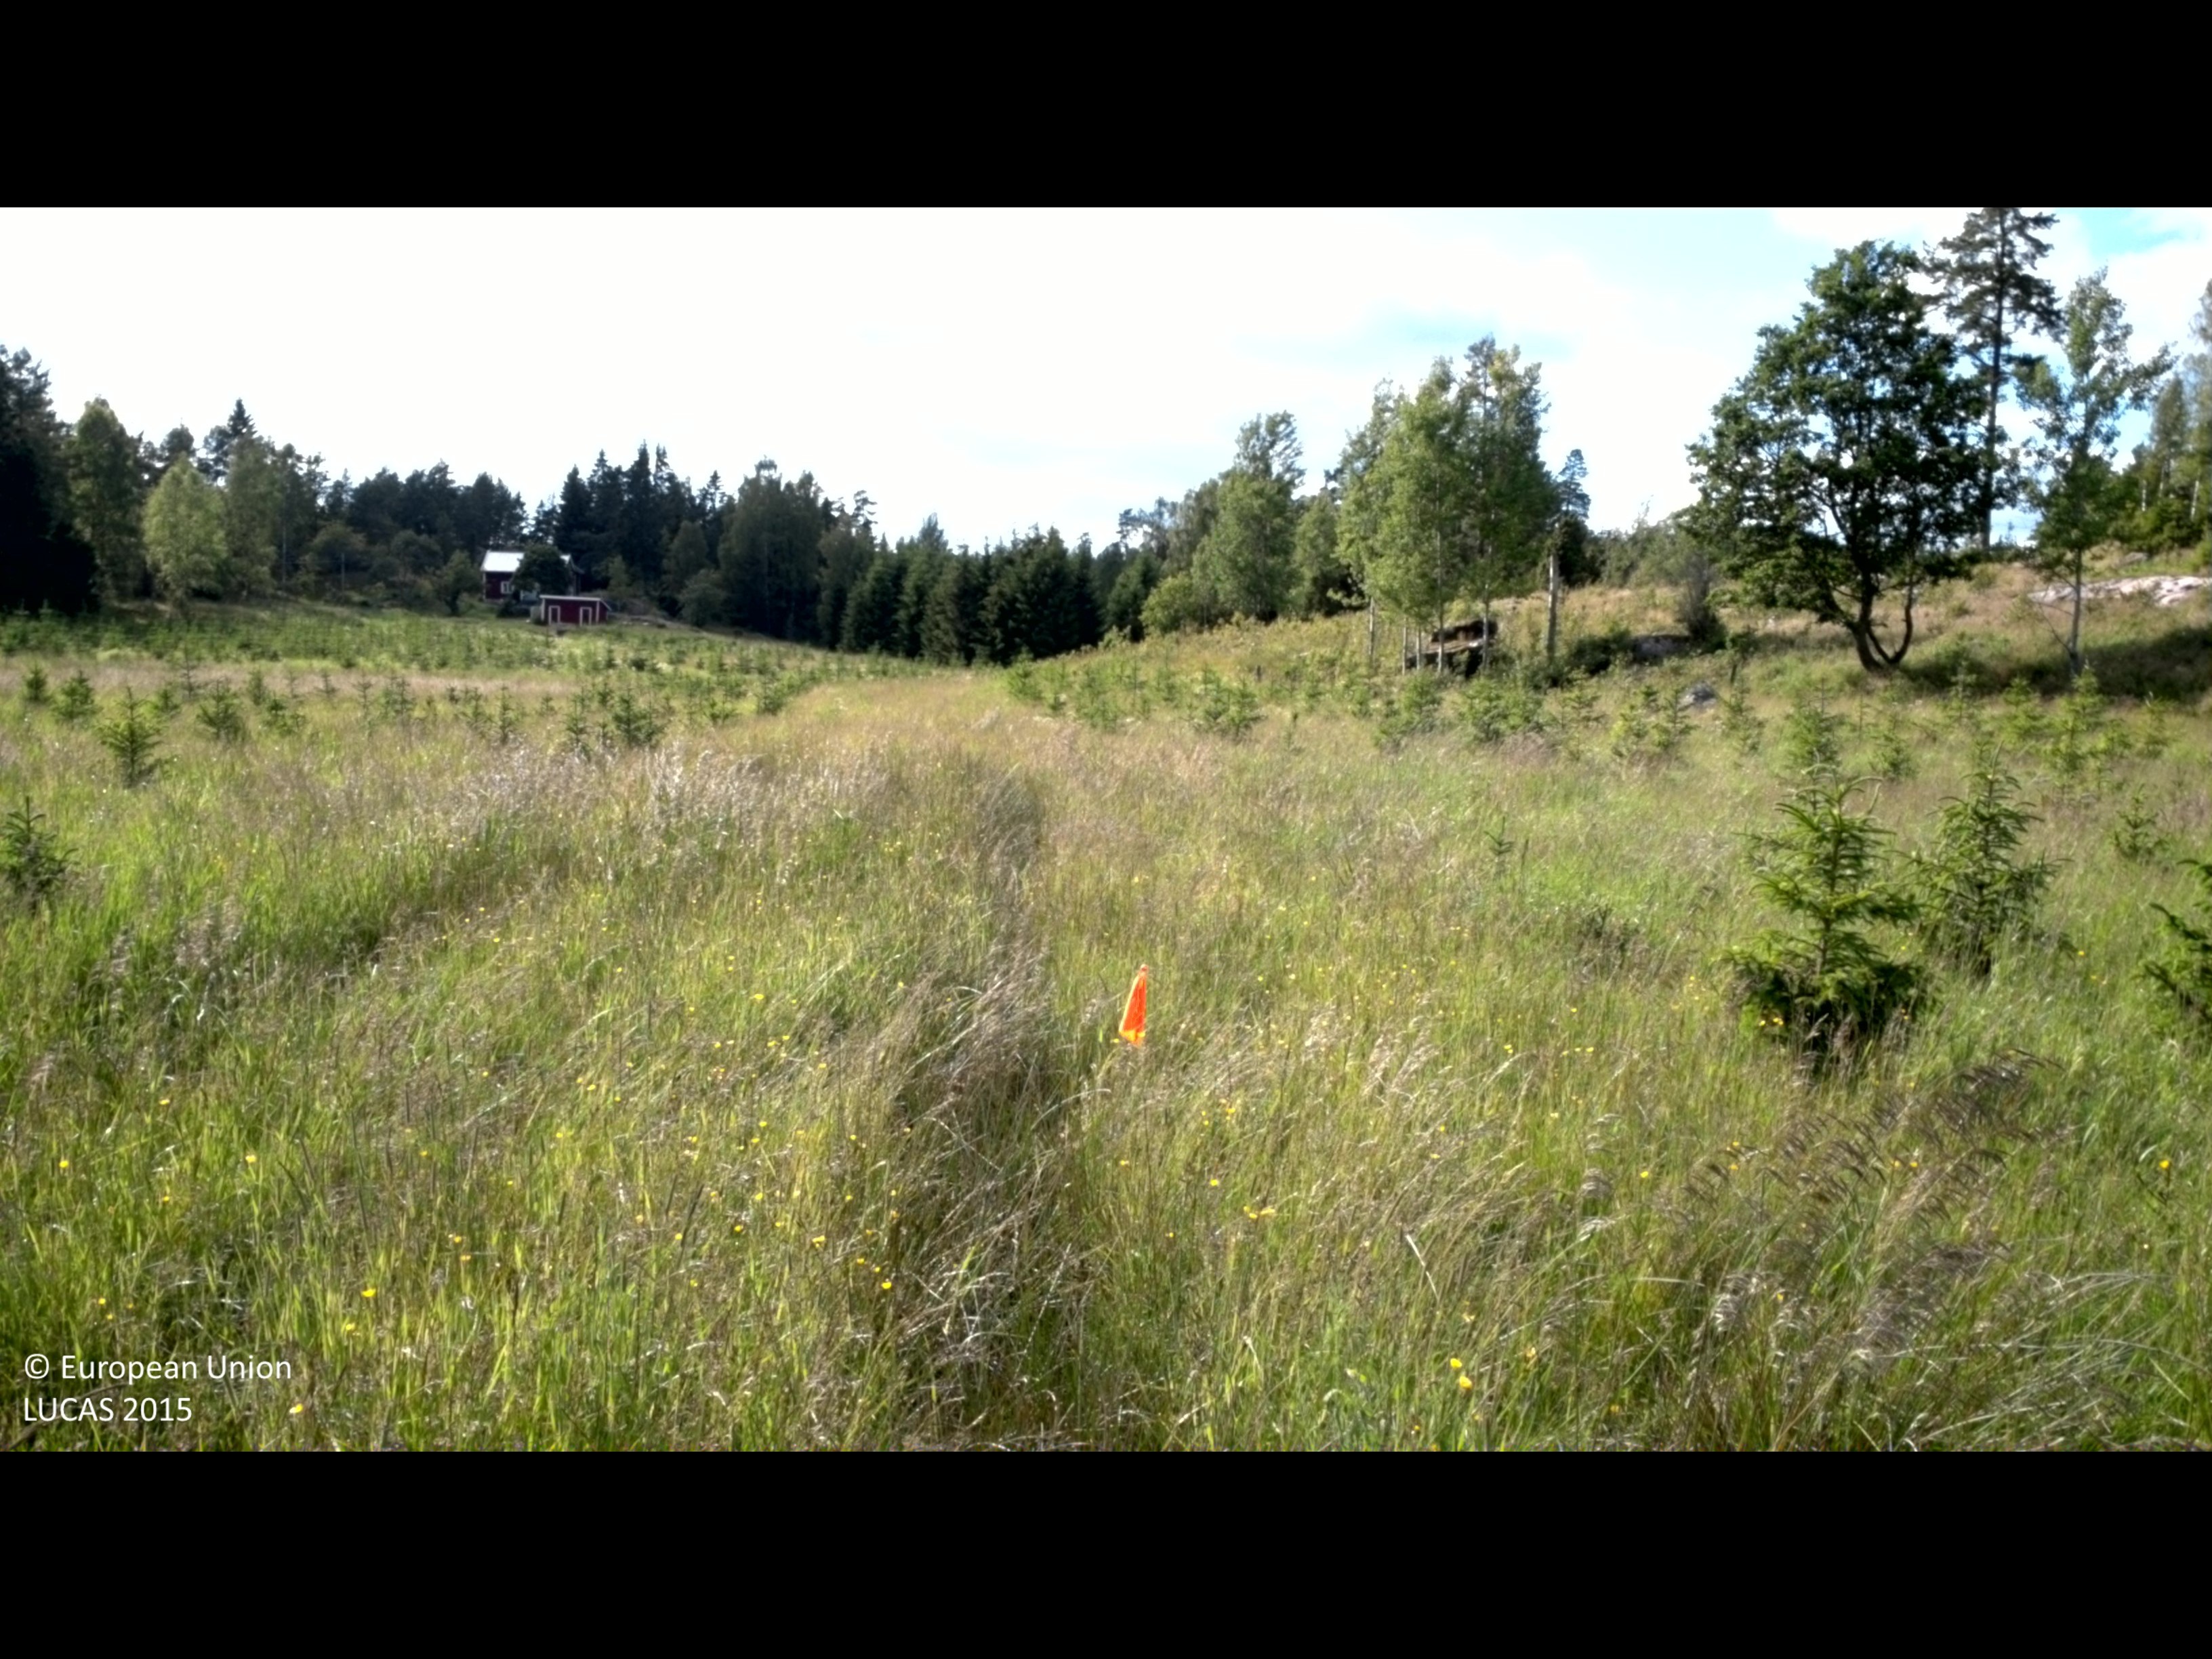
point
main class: Woodland
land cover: Spruce dominated coniferous woodland
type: boreal forest
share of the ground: < 10 %
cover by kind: herbaceous plants 90 %, coniferous forest trees 10 %
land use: Forestry
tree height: < 5 m
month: June
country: SE
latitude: 58.0936
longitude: 16.5965
